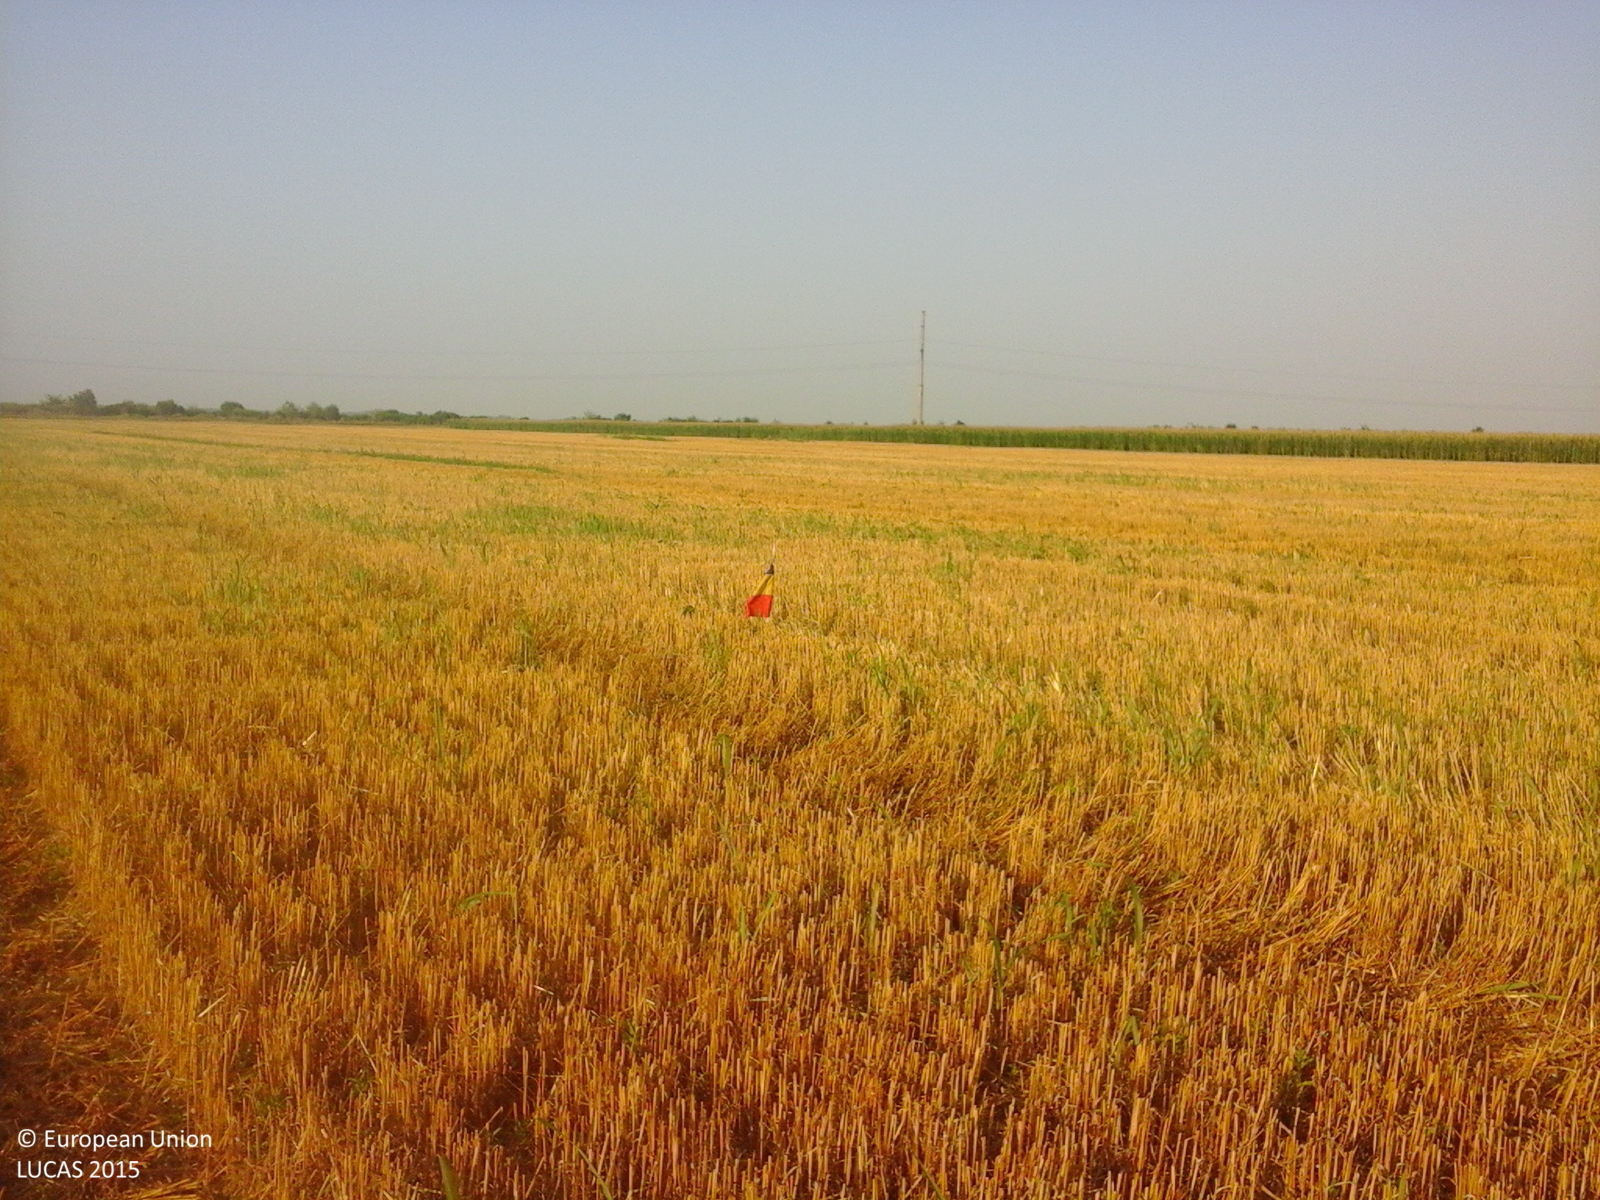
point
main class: Cropland
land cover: Common wheat
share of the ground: 25 - 50 %
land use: Agriculture (excluding fallow land and kitchen gardens)
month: July
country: RO
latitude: 44.6137
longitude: 25.5820
